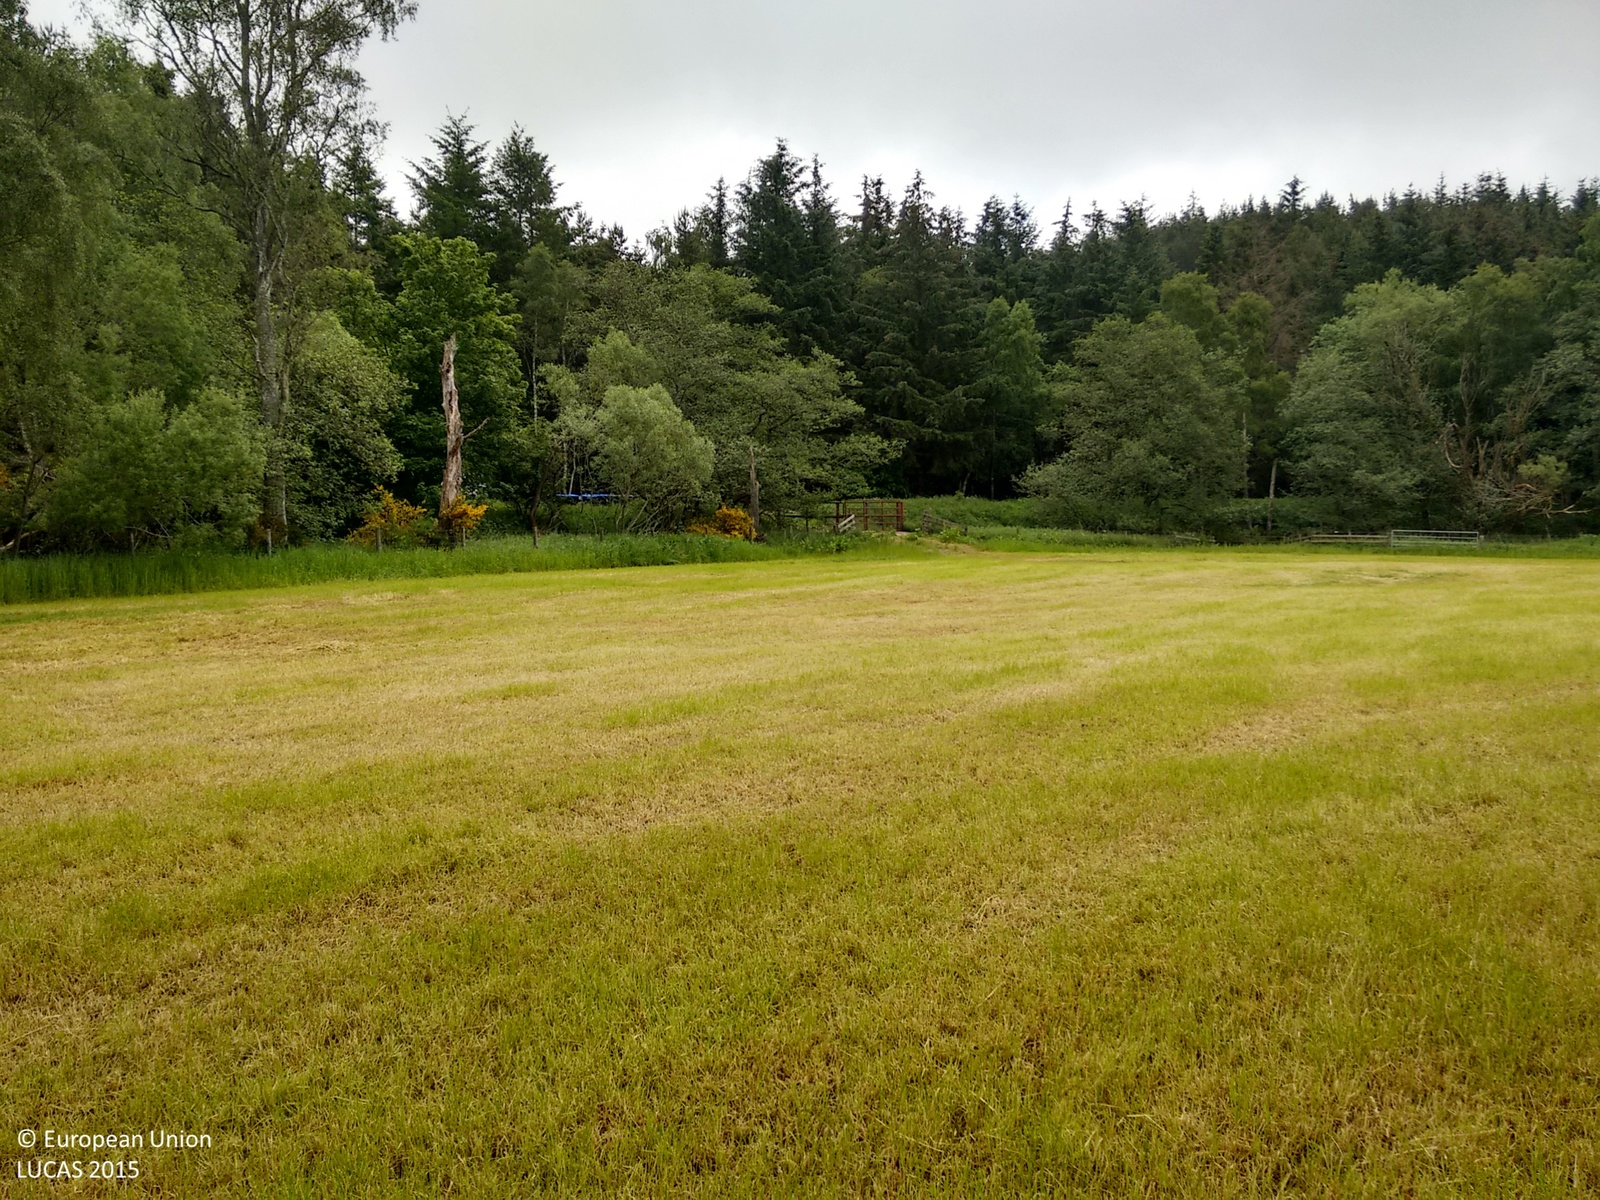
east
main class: Grassland
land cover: Grassland without tree/shrub cover
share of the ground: > 75 %
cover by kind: herbaceous plants 100 %
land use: Agriculture (excluding fallow land and kitchen gardens)
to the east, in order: Grassland without tree/shrub cover; Fences; Broadleaved woodland; Rivers and streams; Broadleaved woodland; Grass margins; Paved roads, cycling and walking lanes; Spruce dominated coniferous woodland; Tracks; Spruce dominated coniferous woodland; Pine dominated coniferous woodland; Spruce dominated mixed woodland
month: June
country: GB
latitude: 57.1173
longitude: -2.9267
